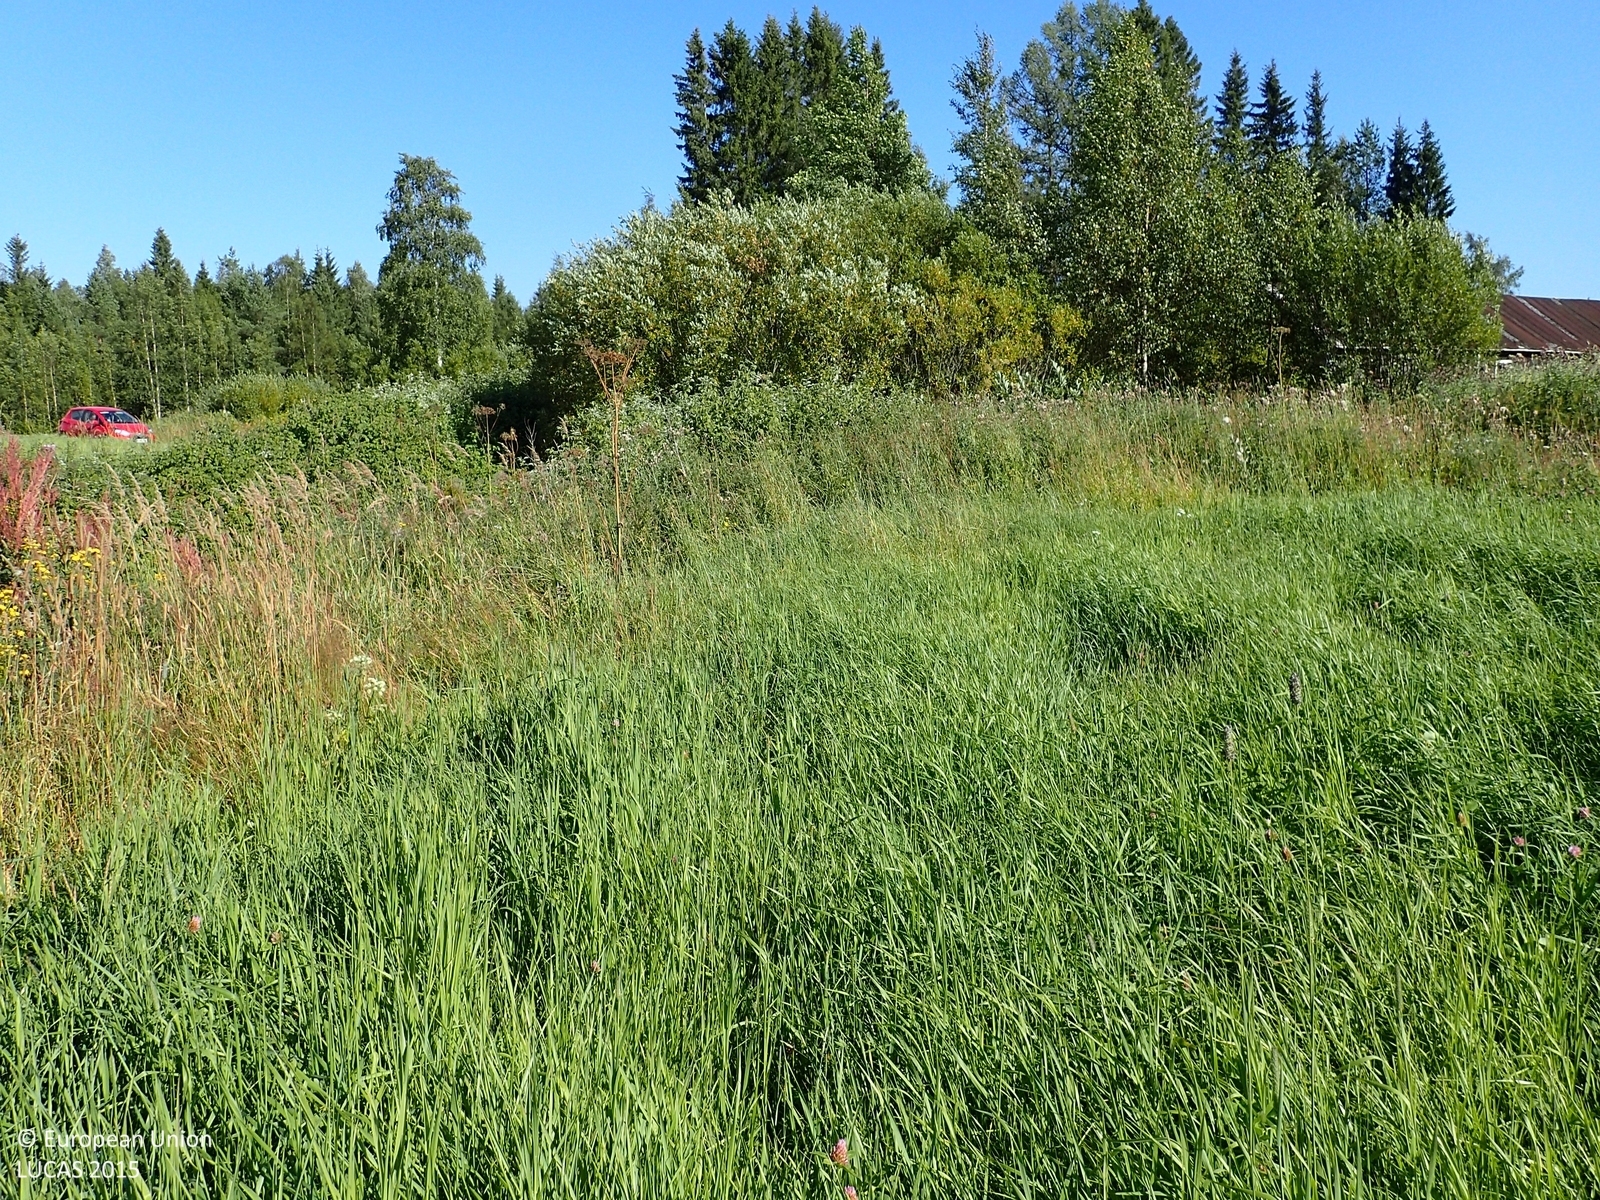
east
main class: Cropland
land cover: Temporary grasslands
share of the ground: > 75 %
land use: Agriculture (excluding fallow land and kitchen gardens)
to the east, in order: Temporary grasslands; Shruby margins; Ditches and canals; Shruby margins; Broadleaved woodland; Ditches and canals; Abandoned hedges; Grass margins; Paved roads, cycling and walking lanes; Grass margins; Ditches and canals; Shruby margins; Temporary grasslands; Ditches and canals; Temporary grasslands; Ditches and canals; Temporary grasslands; Ditches and canals; Temporary grasslands; Ditches and canals; Spruce dominated mixed woodland; Ditches and canals; Spruce dominated mixed woodland; Ditches and canals; Spruce dominated mixed woodland; Ditches and canals; Spruce dominated mixed woodland
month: August
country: FI
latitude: 62.3969
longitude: 21.8687
